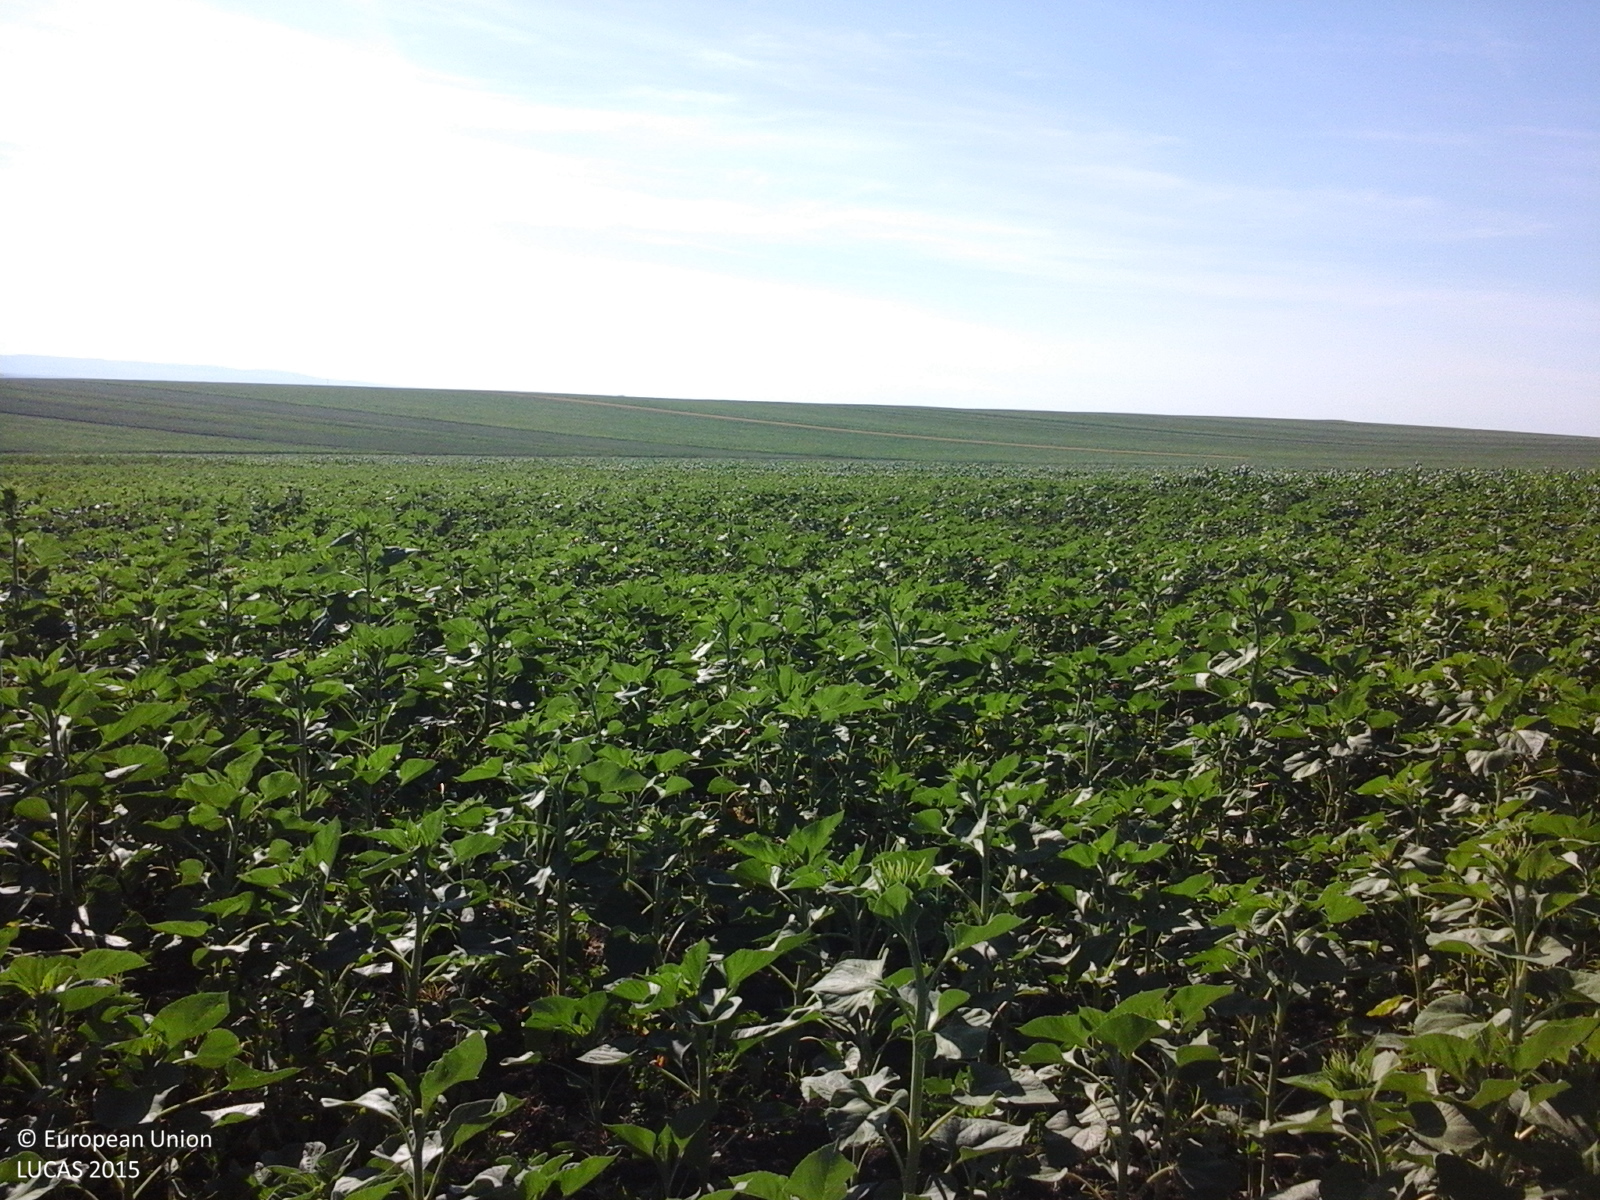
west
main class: Cropland
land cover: Sunflower
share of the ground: 50 - 75 %
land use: Agriculture (excluding fallow land and kitchen gardens)
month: June
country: RO
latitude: 47.4768
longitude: 27.2409
